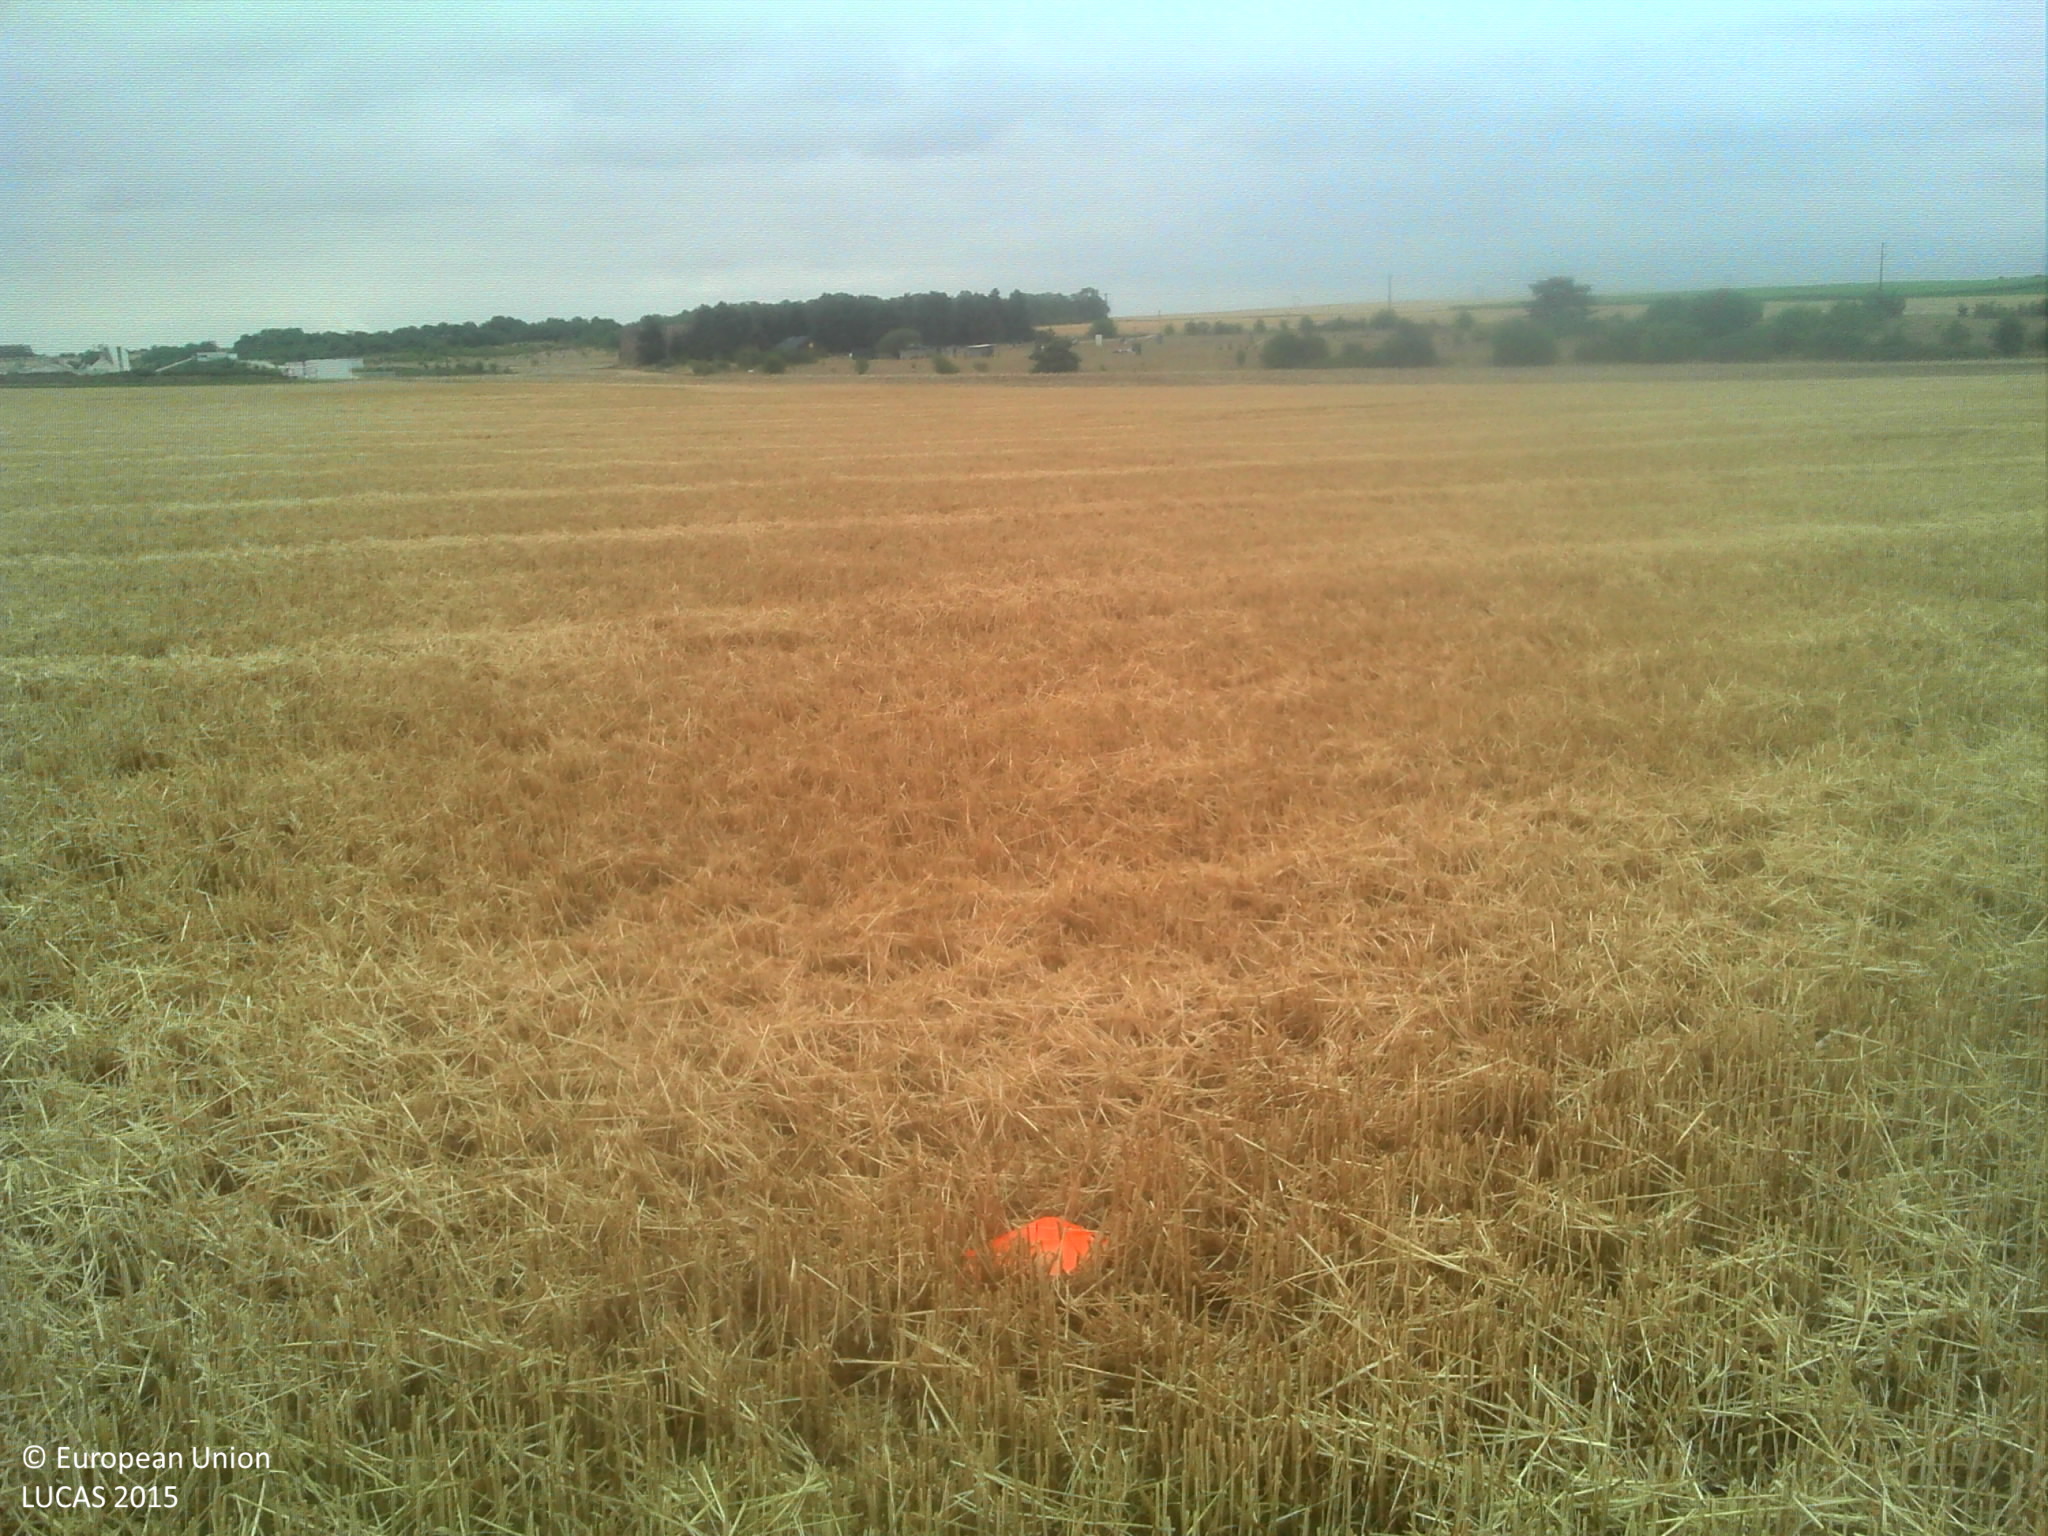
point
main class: Cropland
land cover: Durum wheat
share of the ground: > 75 %
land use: Agriculture (excluding fallow land and kitchen gardens)
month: July
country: FR
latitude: 47.6831
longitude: 1.3388
